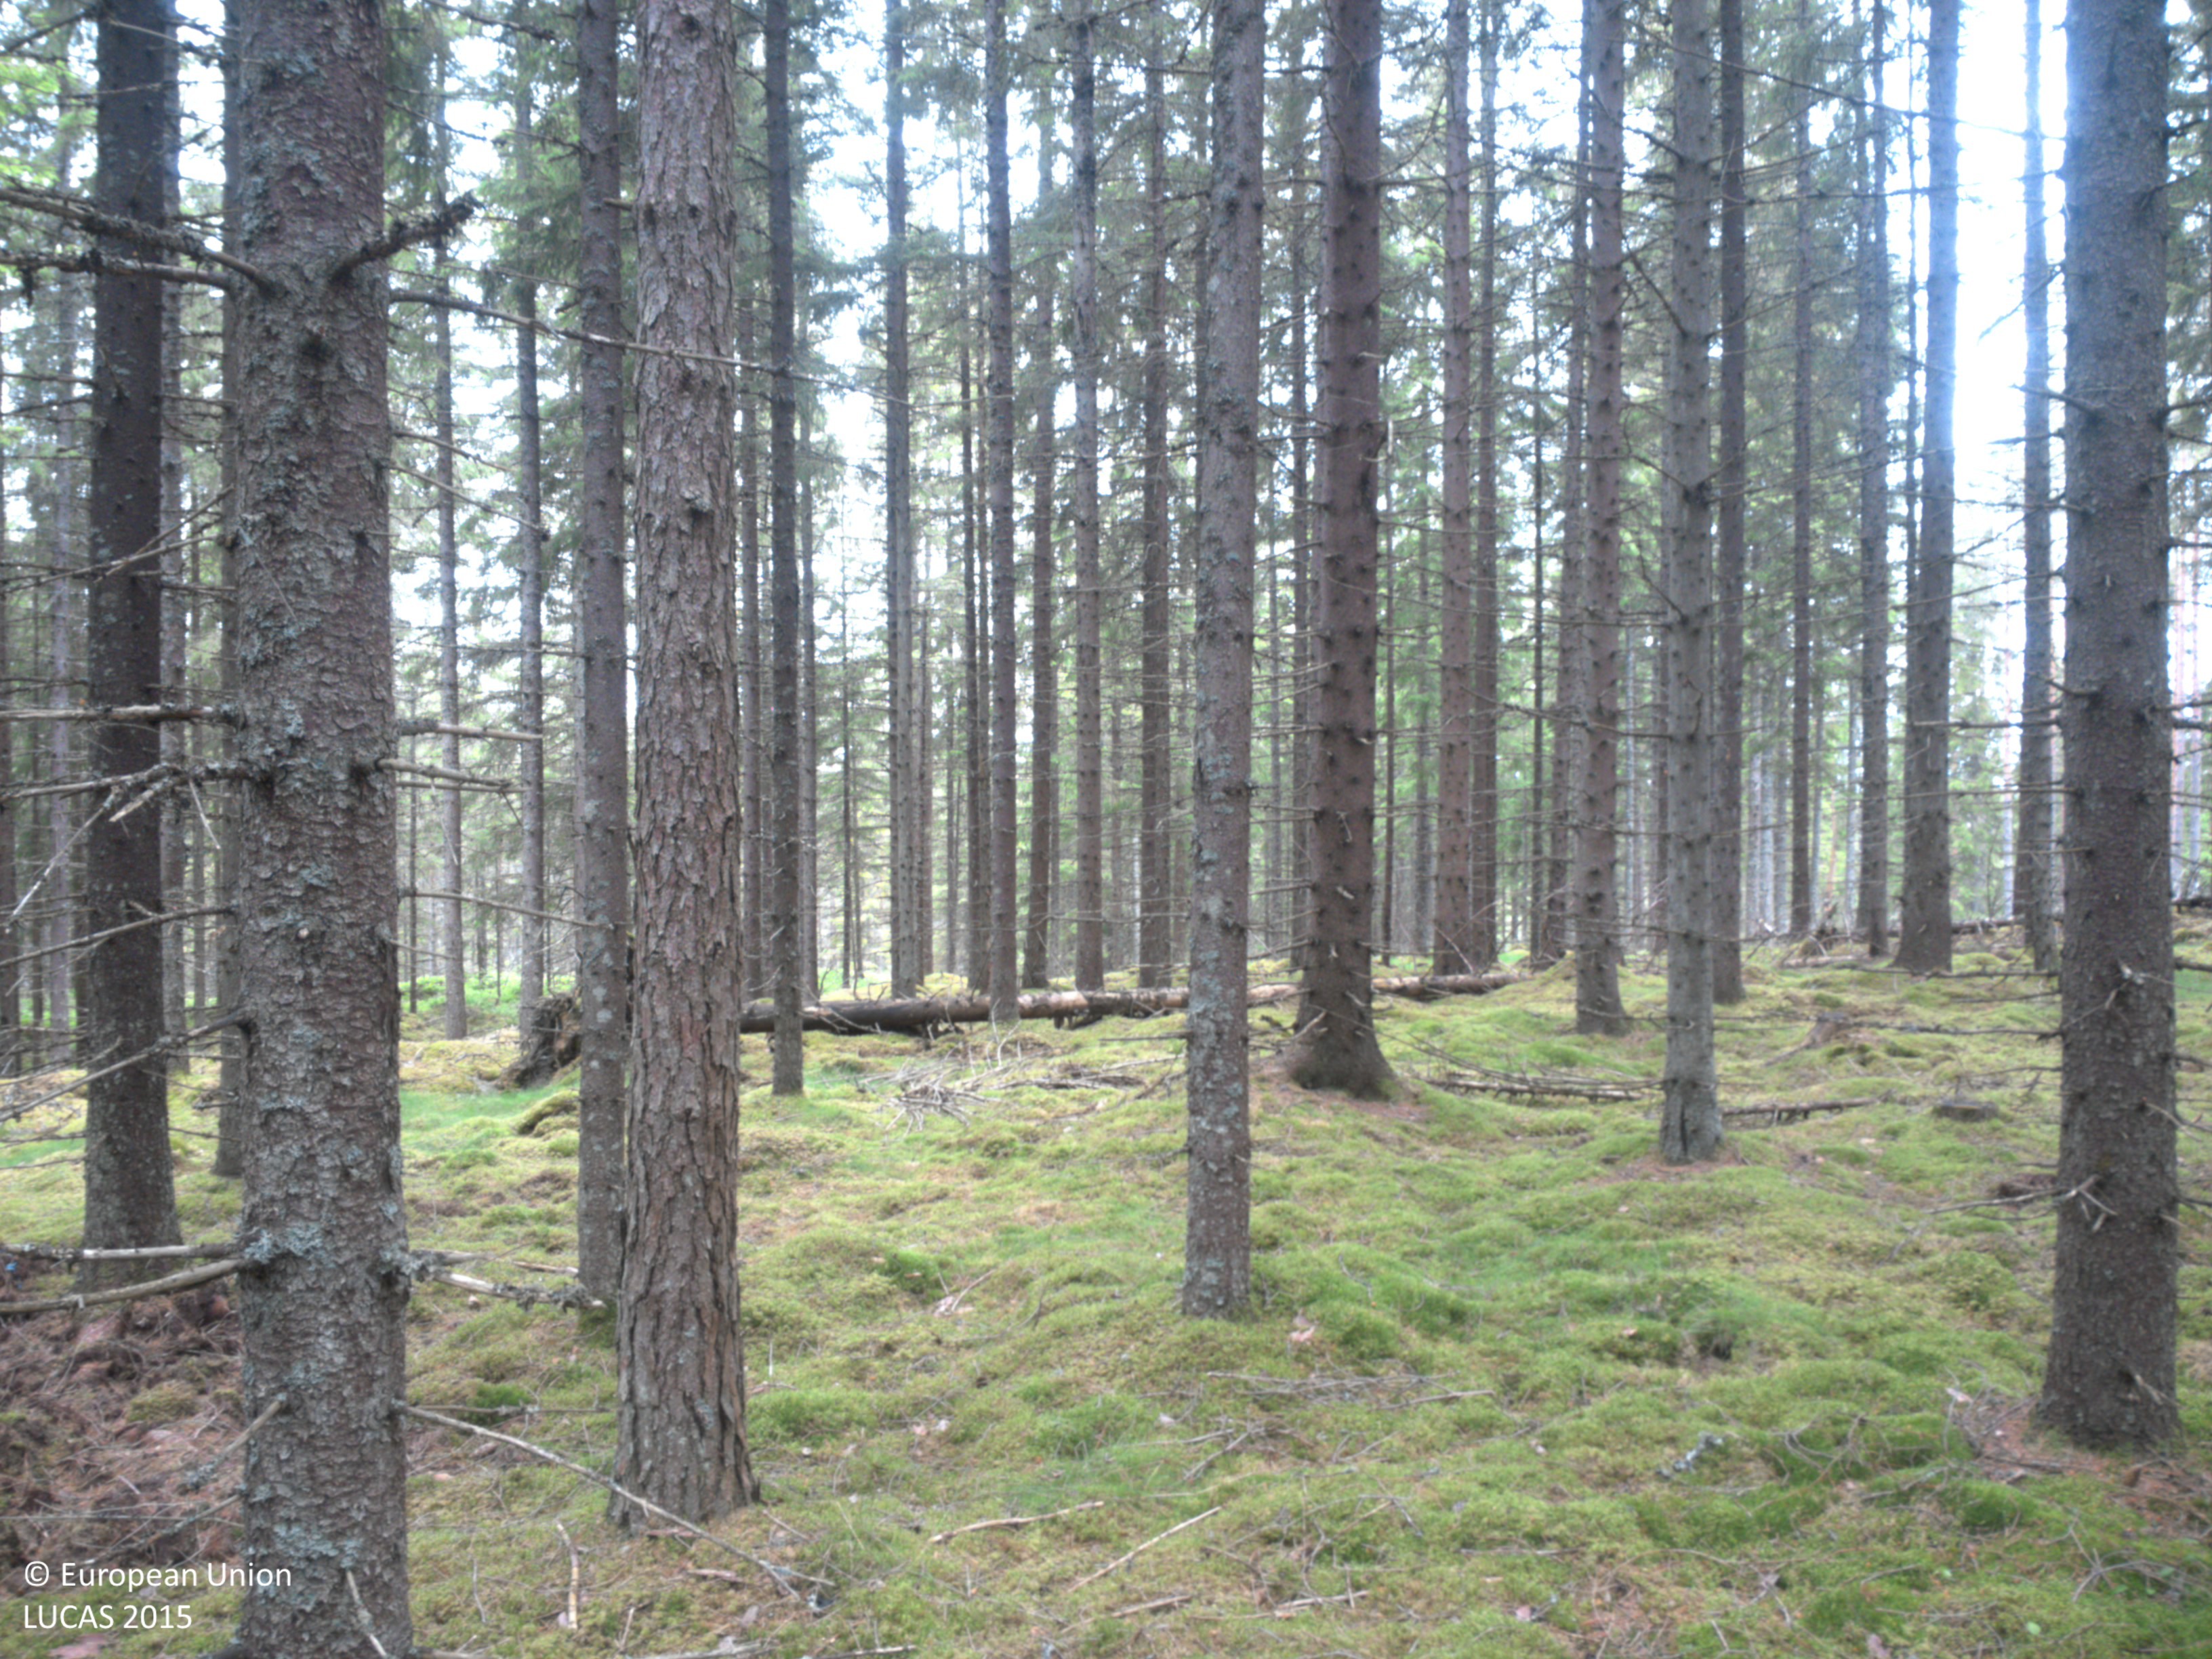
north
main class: Woodland
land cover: Spruce dominated coniferous woodland
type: boreal forest
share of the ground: 50 - 75 %
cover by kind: coniferous forest trees 65 %, lichens and mosses 35 %
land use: Forestry
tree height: > 5 m
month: June
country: SE
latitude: 58.9969
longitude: 11.9622
